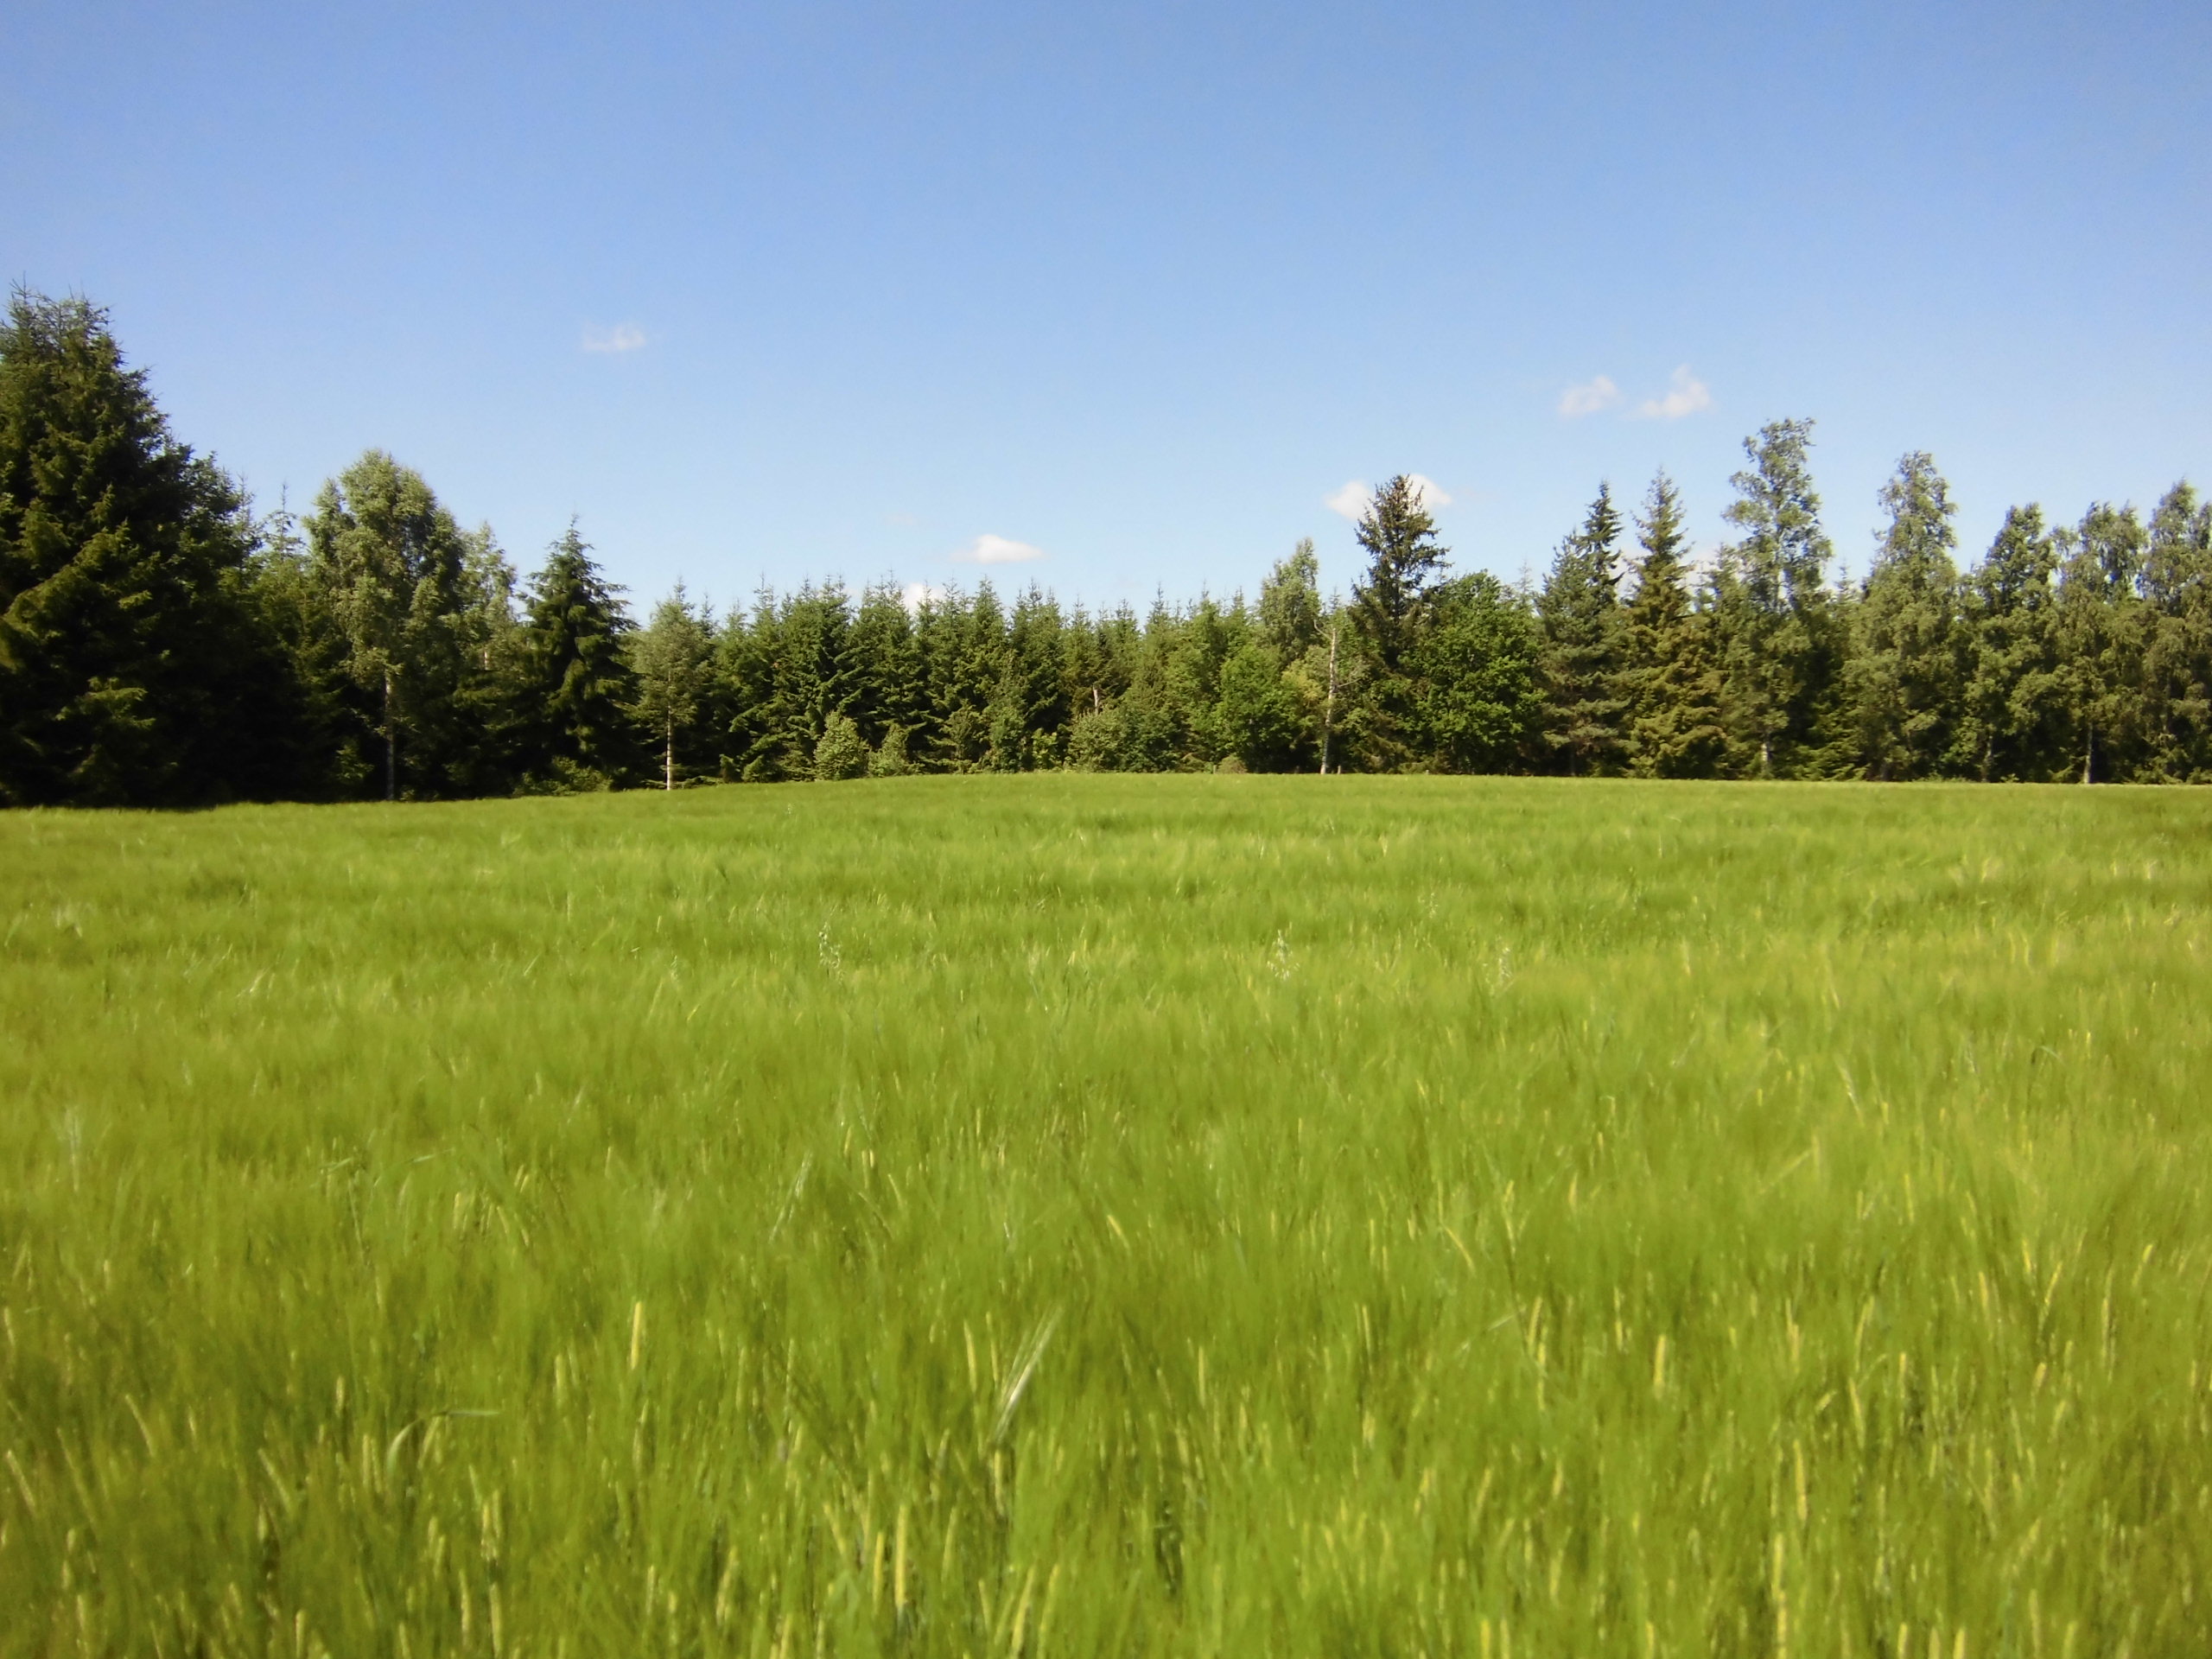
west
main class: Cropland
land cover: Barley
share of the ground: > 75 %
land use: Agriculture (excluding fallow land and kitchen gardens)
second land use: Amenities, museums, leisure
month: July
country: SE
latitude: 57.3221
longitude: 15.2943
